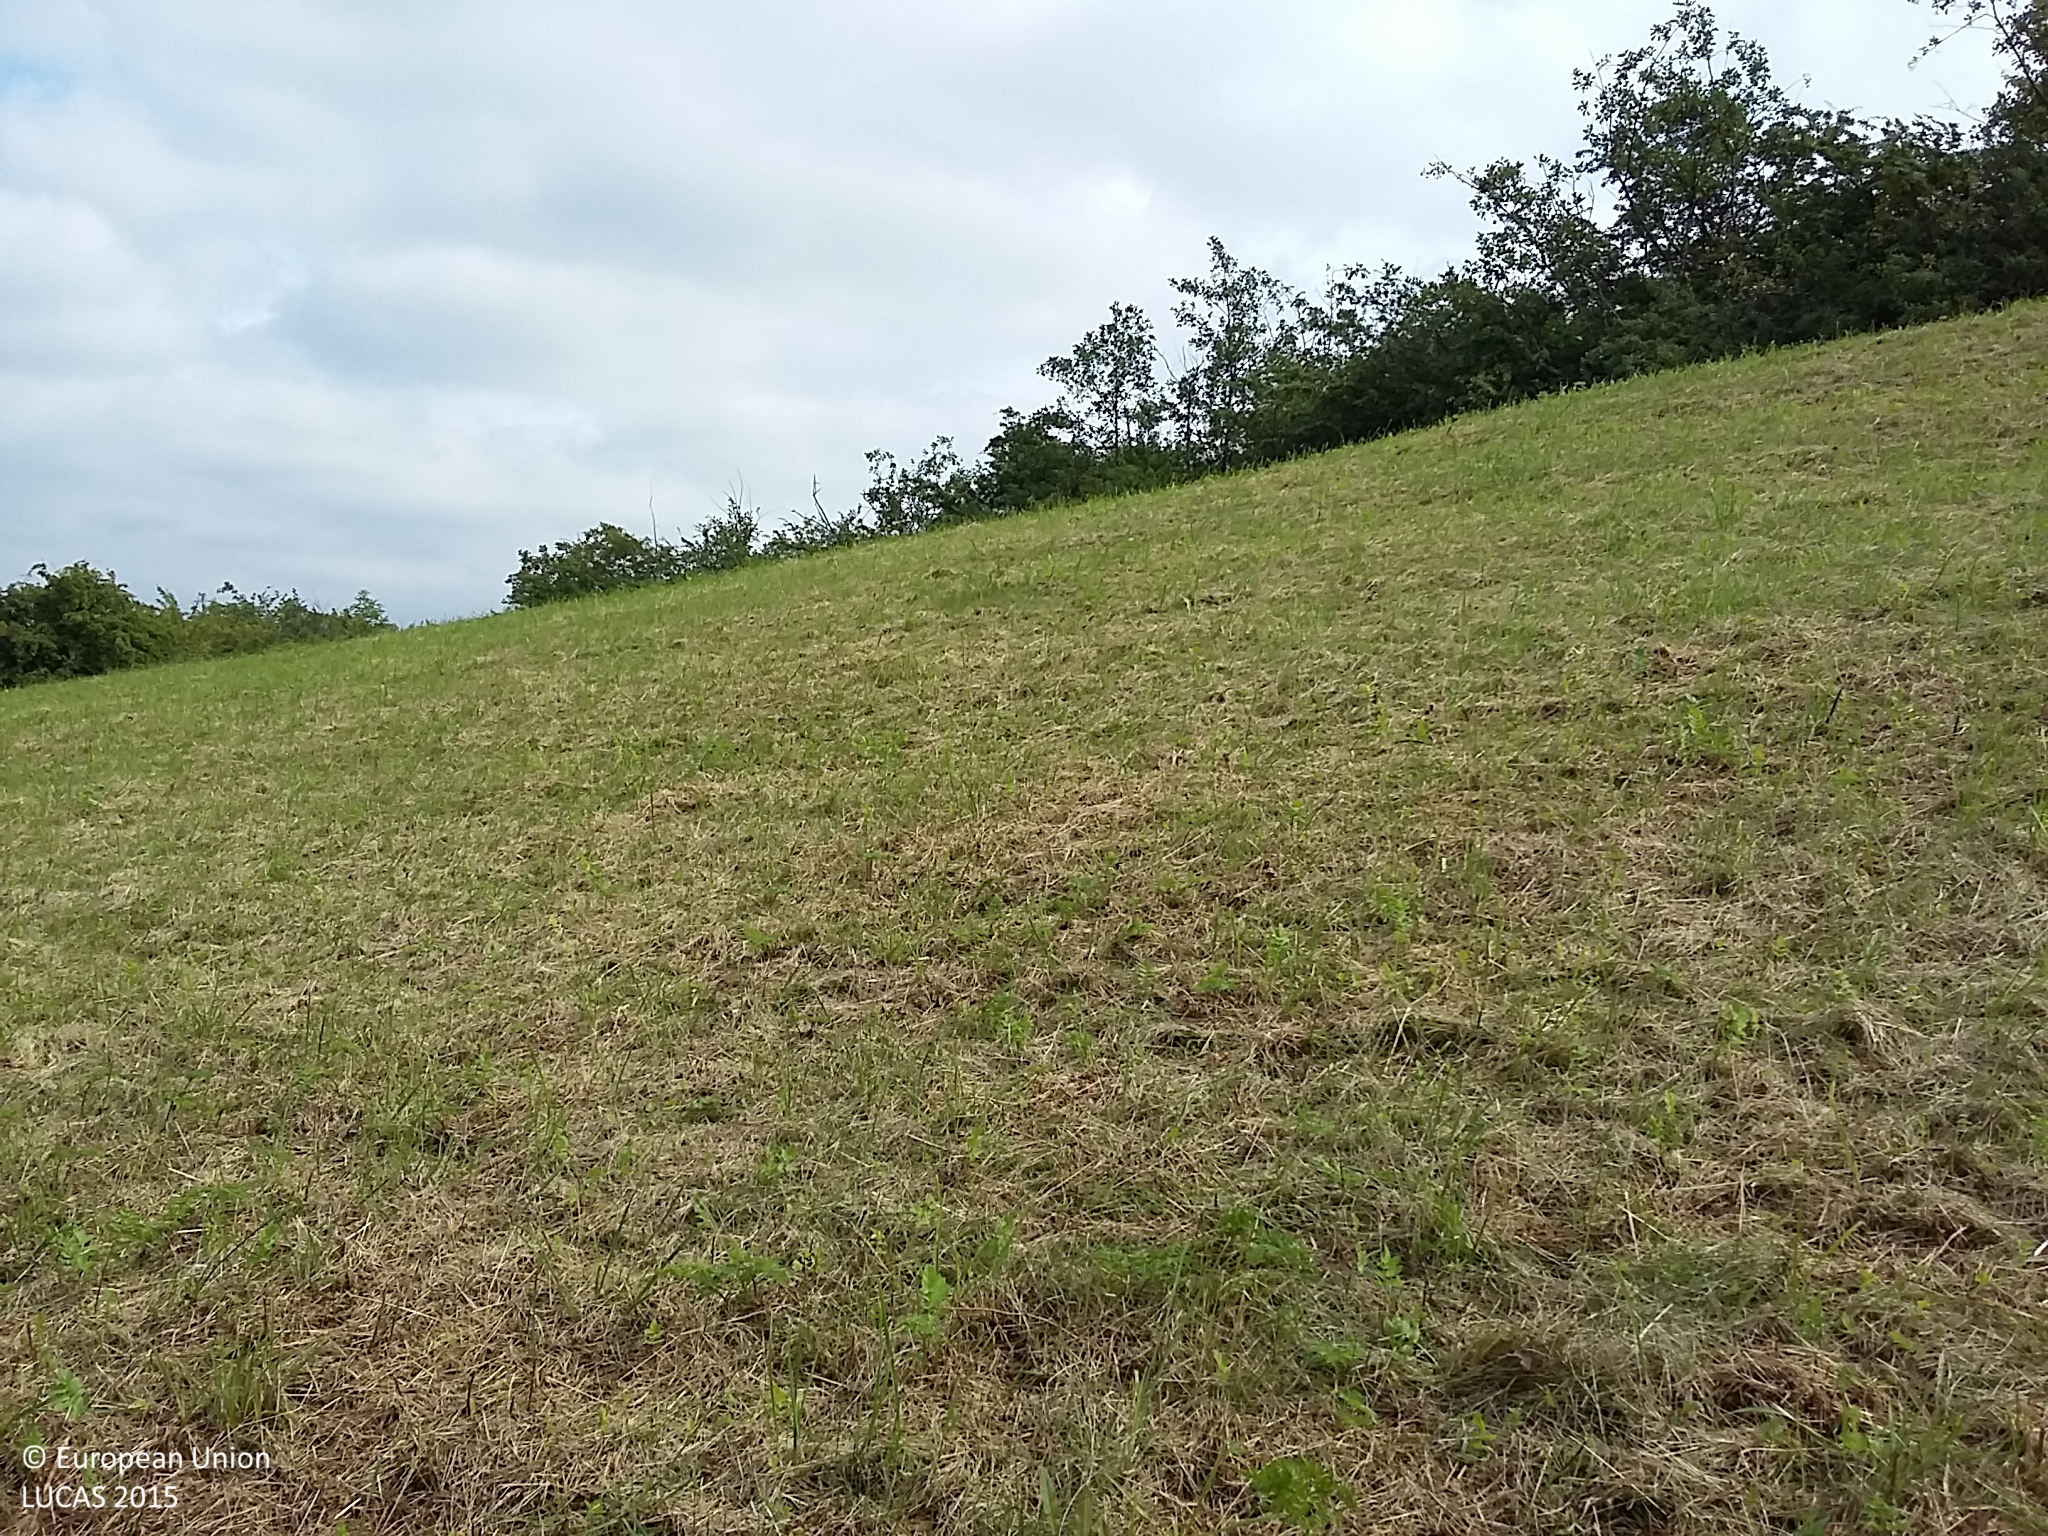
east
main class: Grassland
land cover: Grassland without tree/shrub cover
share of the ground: > 75 %
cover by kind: herbaceous plants 100 %
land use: Amenities, museums, leisure
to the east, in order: Grassland without tree/shrub cover; Broadleaved woodland; Grassland without tree/shrub cover; Broadleaved woodland; Grassland without tree/shrub cover; Broadleaved woodland; Grassland without tree/shrub cover
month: August
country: DK
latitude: 55.6091
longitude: 12.3317
